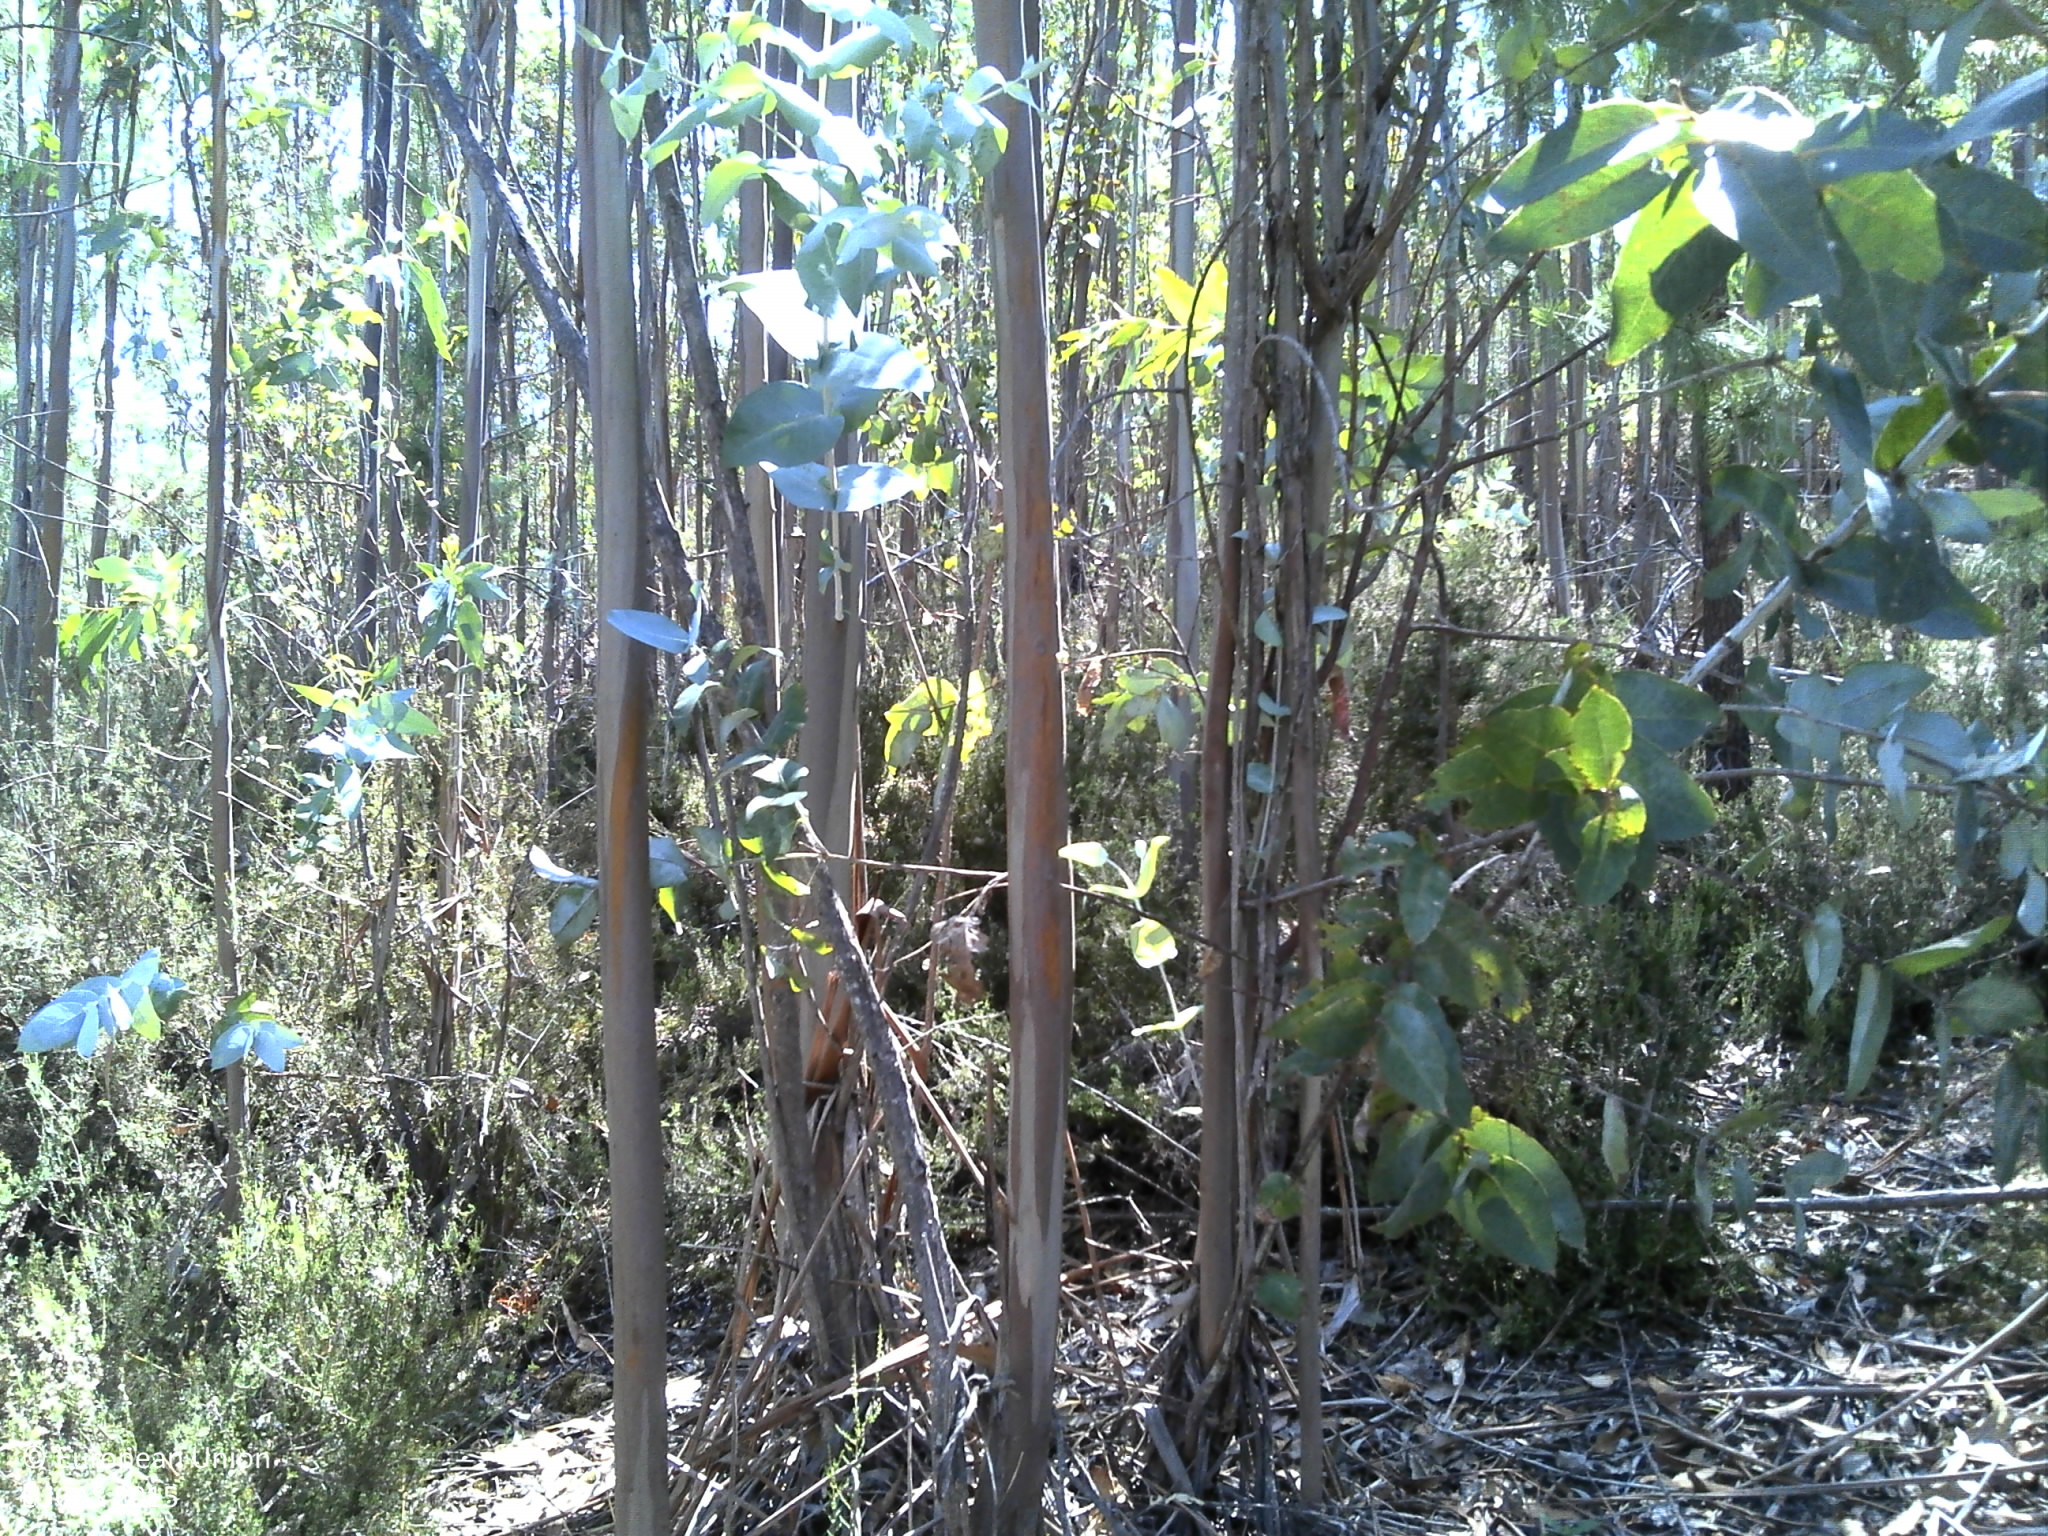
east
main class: Woodland
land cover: Broadleaved woodland
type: exotic forest
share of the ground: 10 - 25 %
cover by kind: shrubs 80 %, broadleaved forest trees 15 %, unconsolidated bare surface 5 %
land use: Forestry
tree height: > 5 m
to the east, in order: Broadleaved woodland; Tracks; Broadleaved woodland; Tracks; Broadleaved woodland
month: July
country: PT
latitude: 40.0099
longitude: -8.1967
